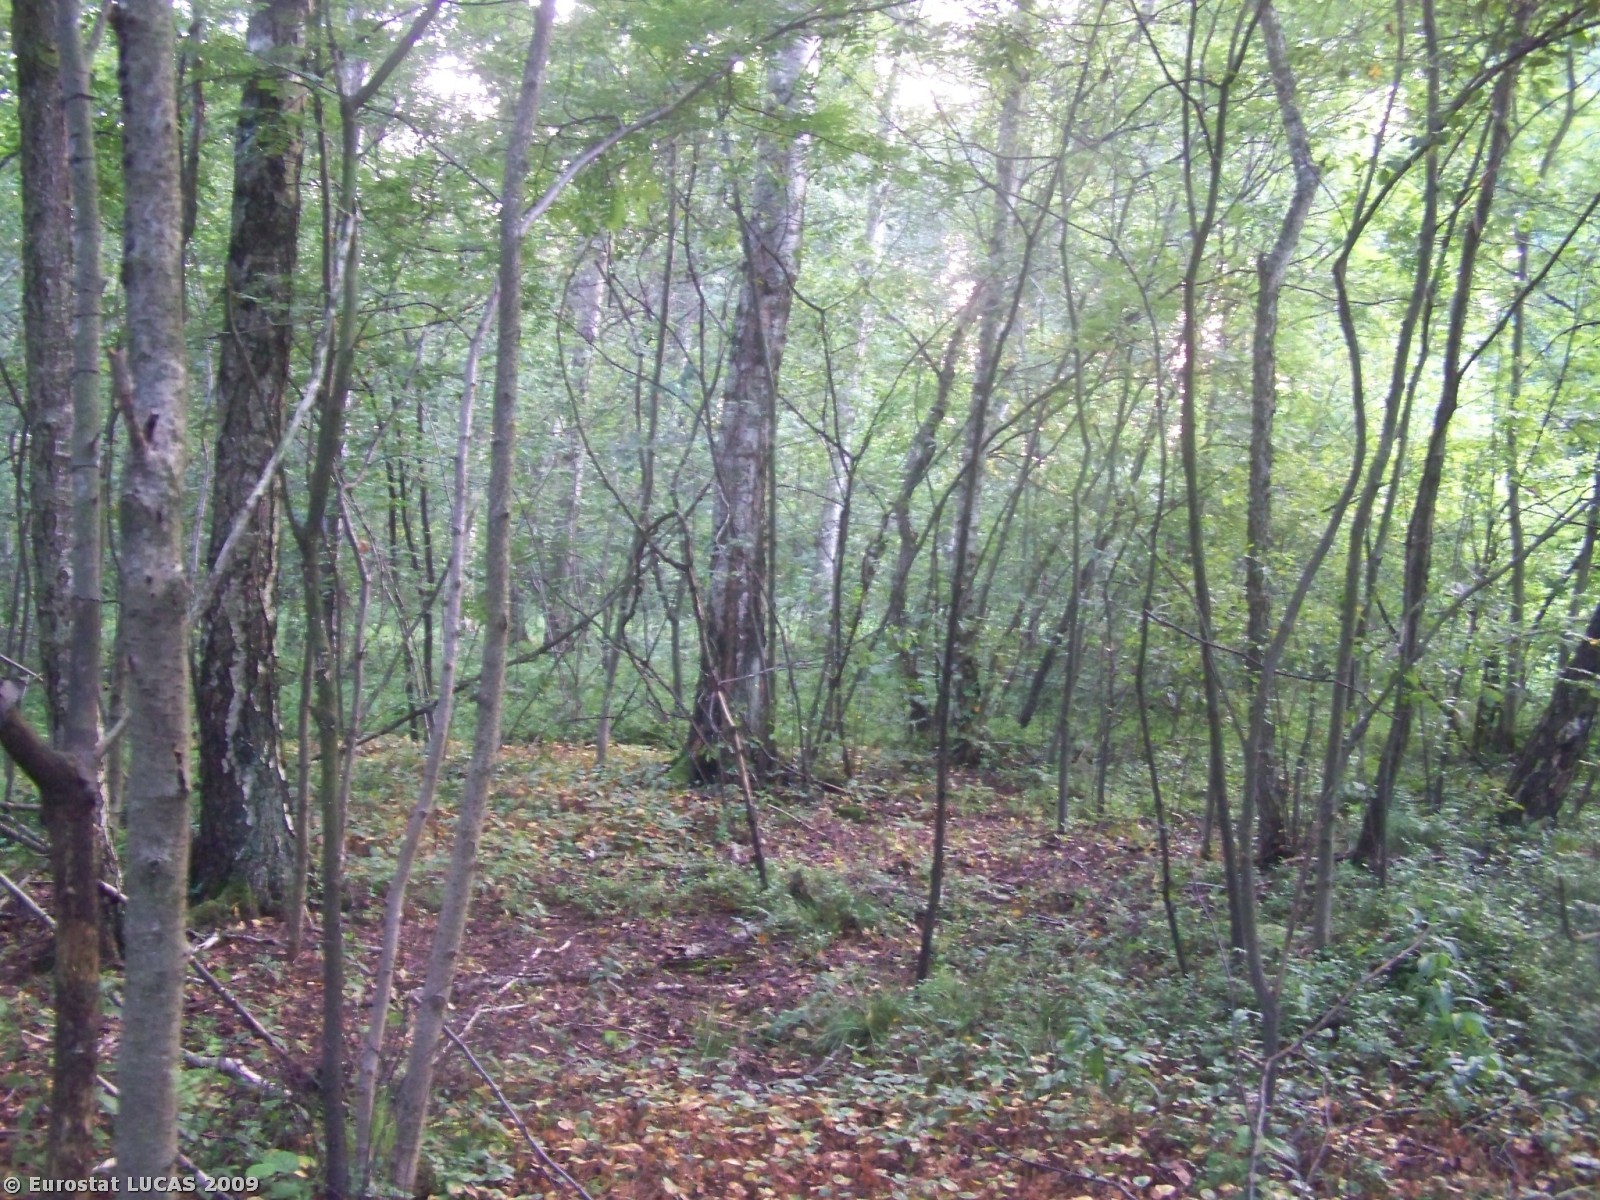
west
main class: Woodland
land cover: Broadleaved woodland
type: non-riverine alder, birch or aspen forest
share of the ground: > 75 %
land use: Forestry
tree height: > 5 m
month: July
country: PL
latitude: 52.2744
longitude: 21.6458
